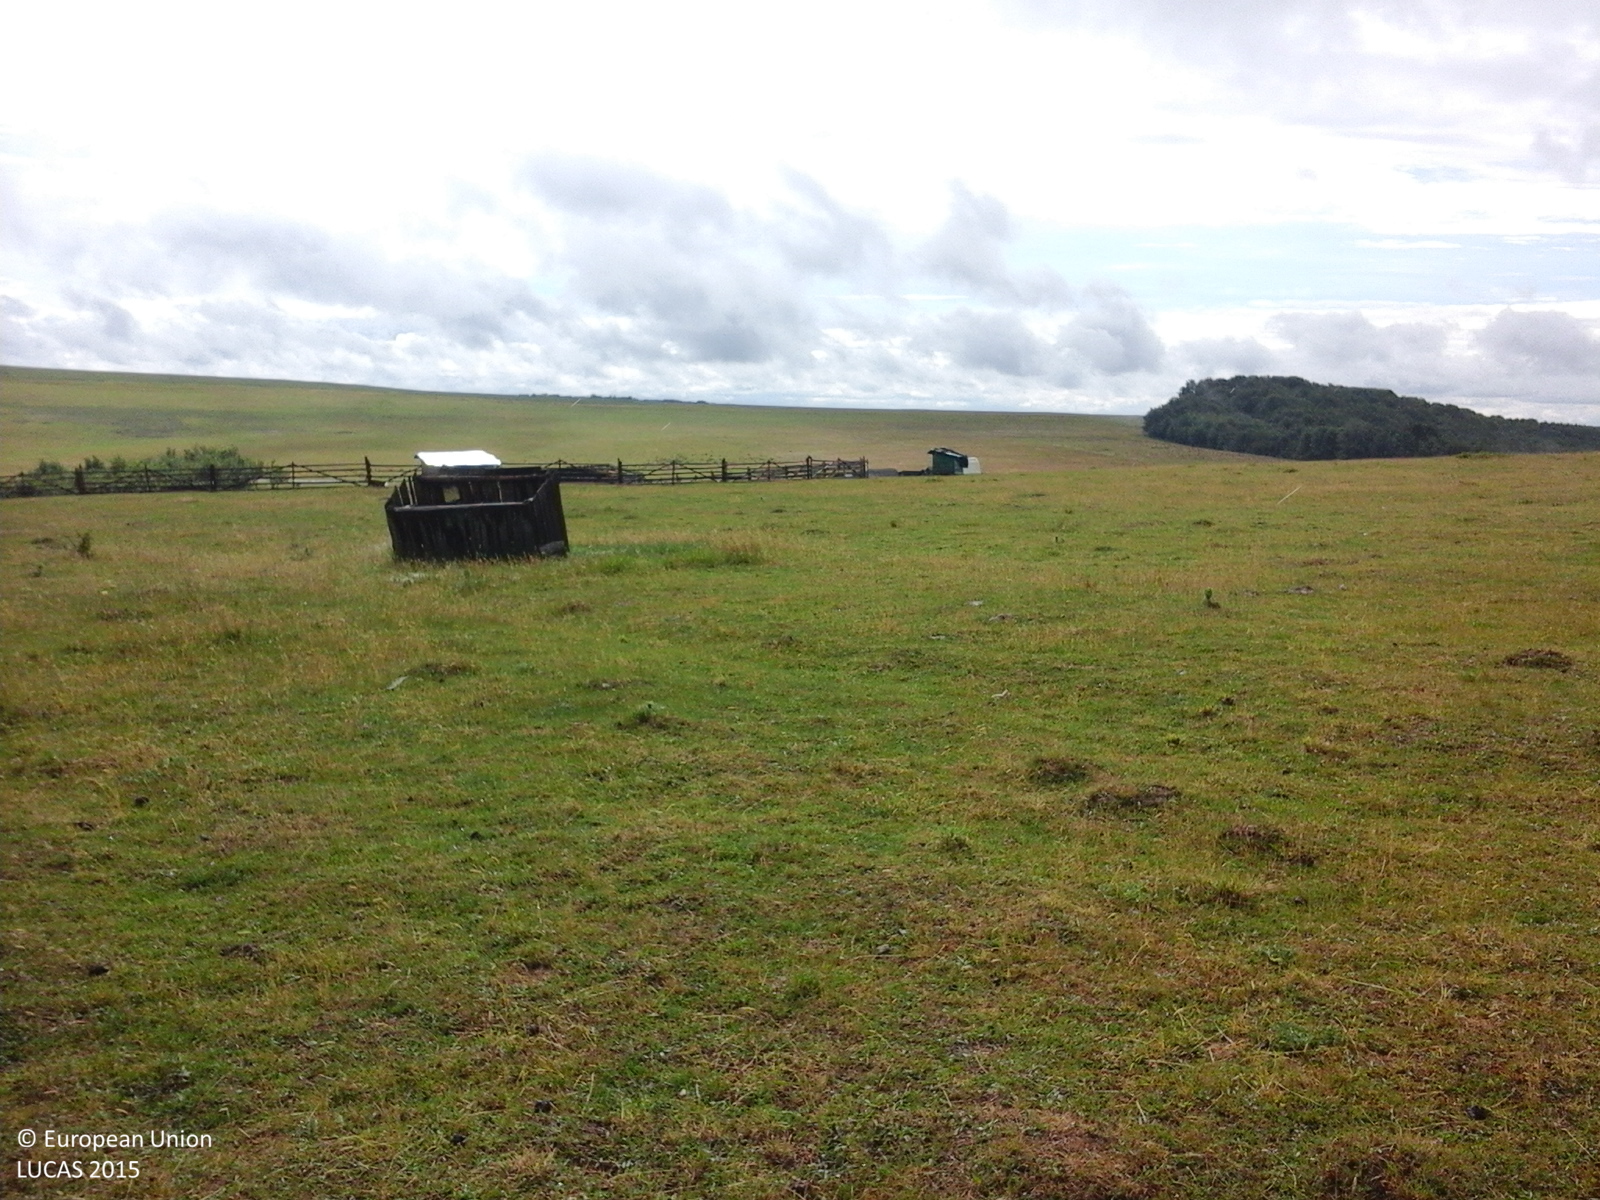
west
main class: Grassland
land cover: Grassland without tree/shrub cover
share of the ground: > 75 %
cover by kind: herbaceous plants 100 %
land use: Agriculture (excluding fallow land and kitchen gardens)
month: June
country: RO
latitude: 47.4202
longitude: 26.4301
